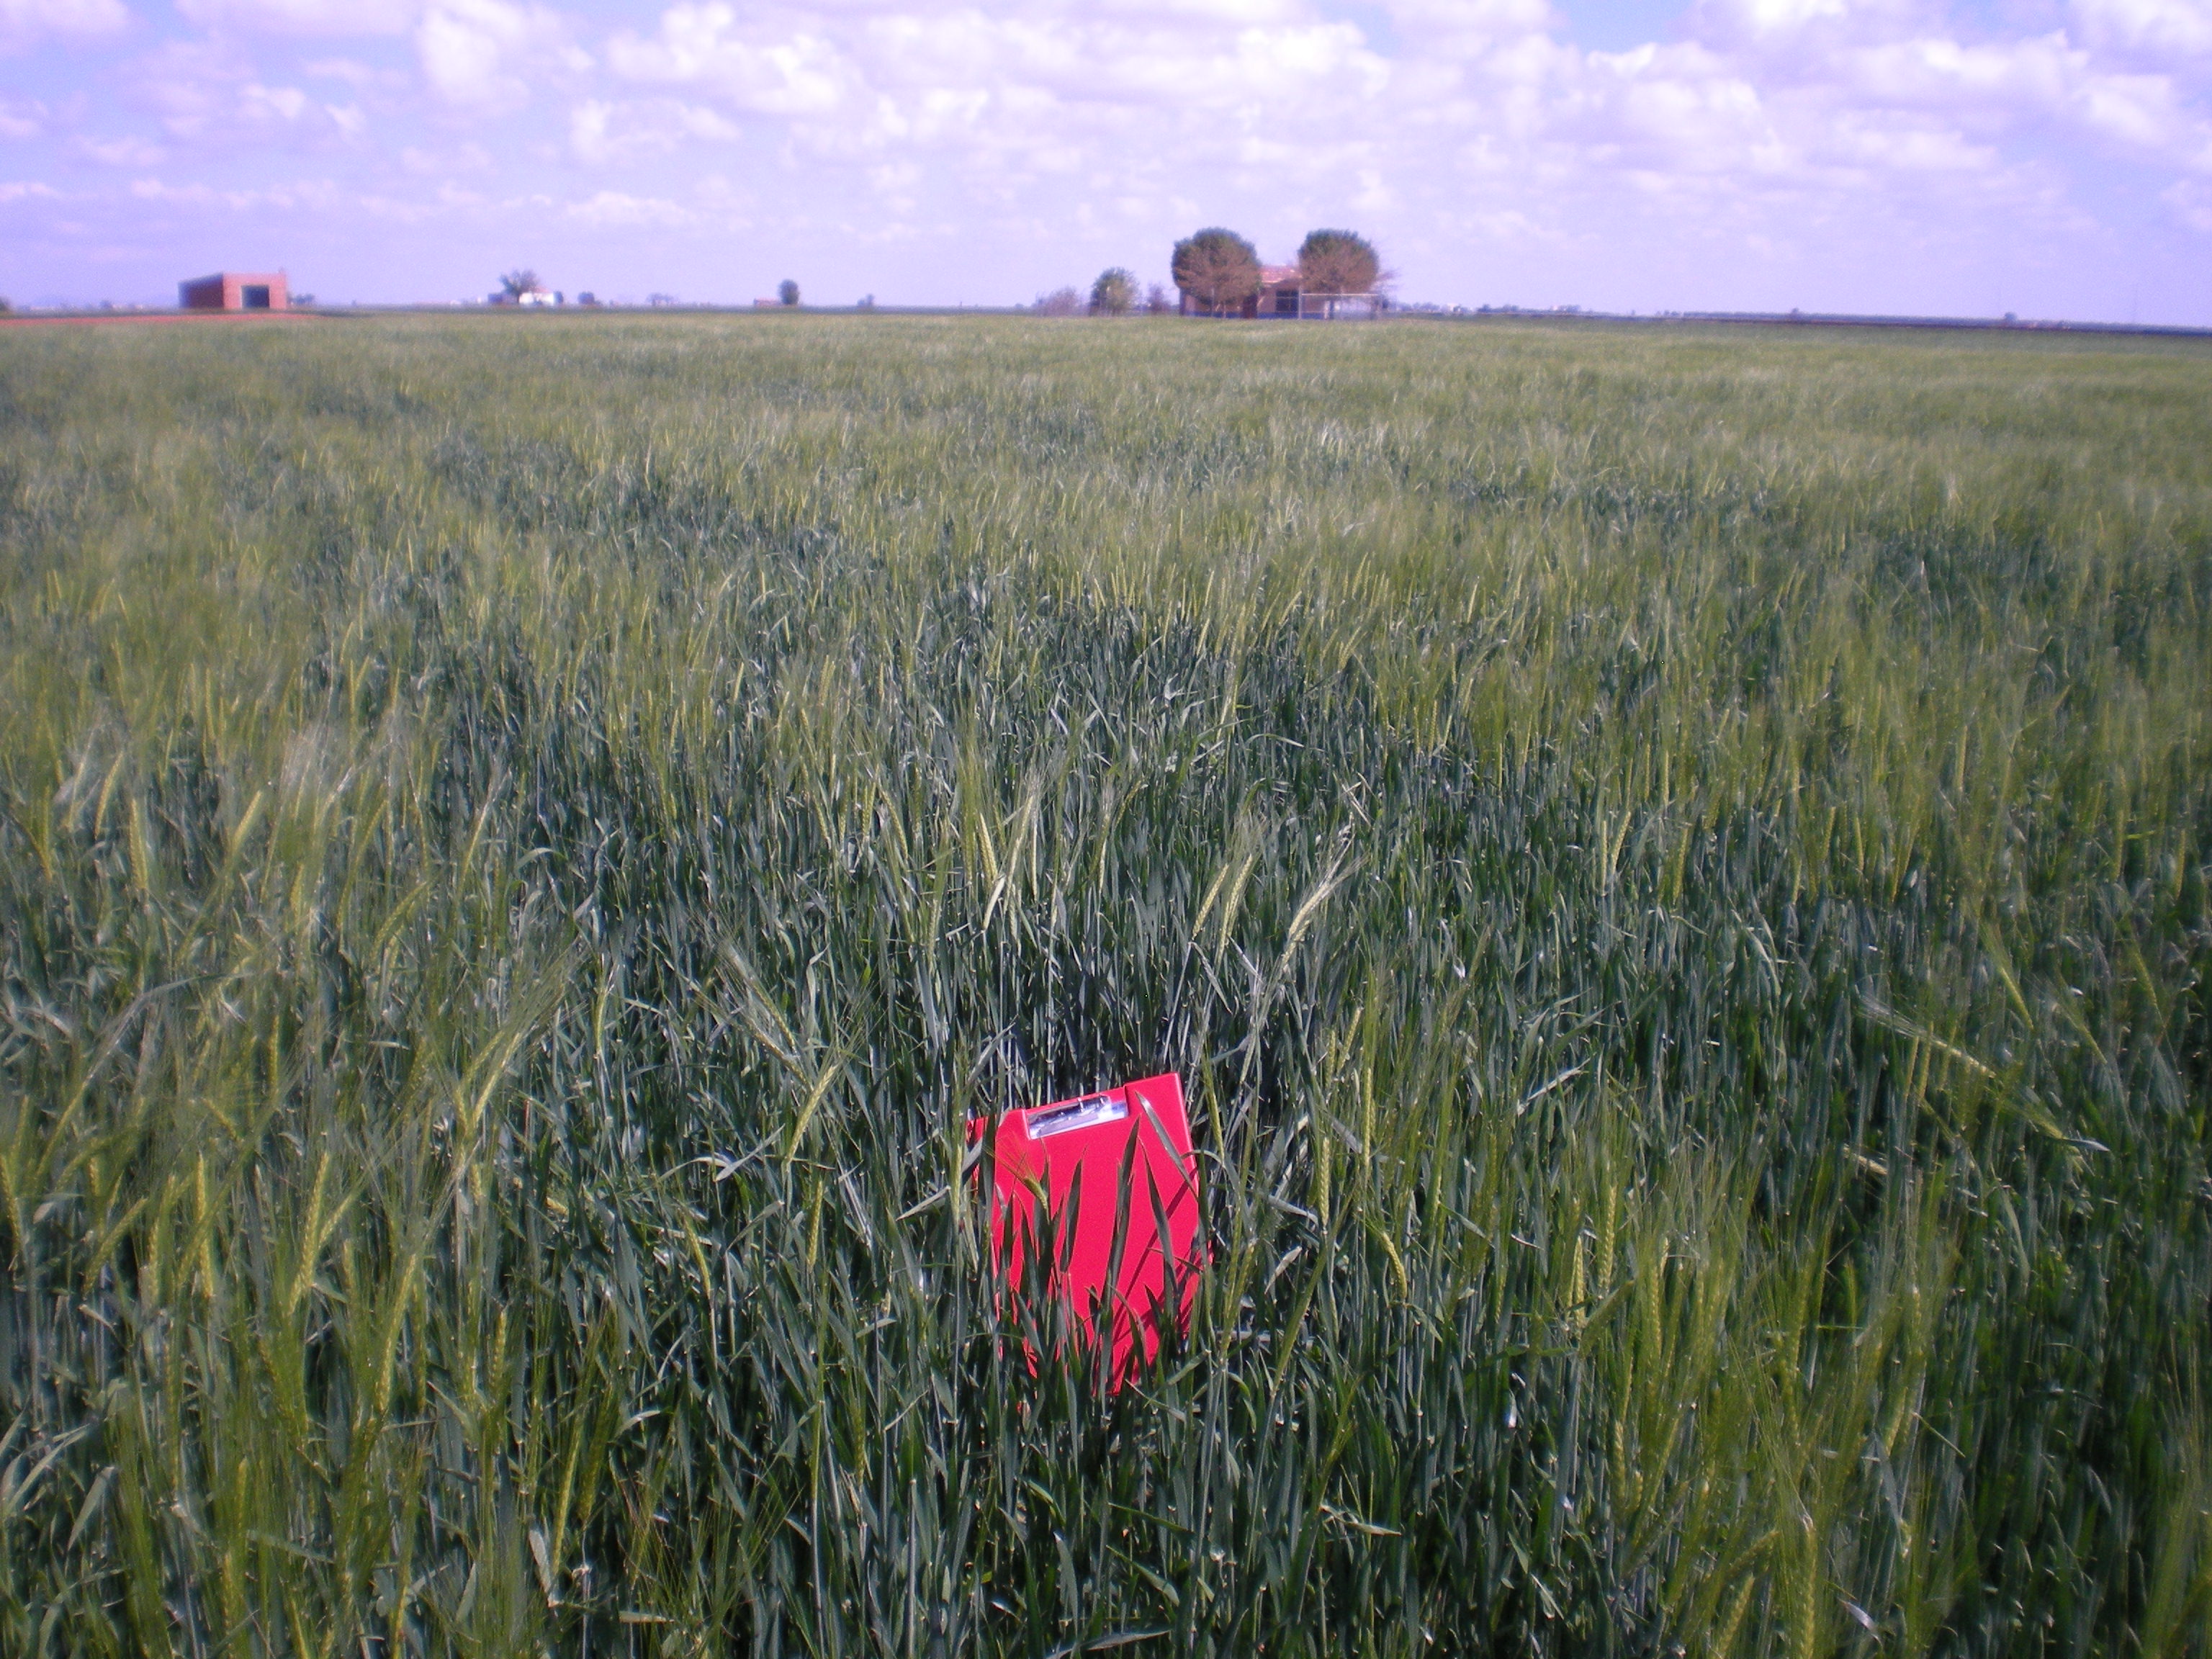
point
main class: Cropland
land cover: Barley
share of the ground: > 75 %
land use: Agriculture (excluding fallow land and kitchen gardens)
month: April
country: ES
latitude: 38.9736
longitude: -3.5551
